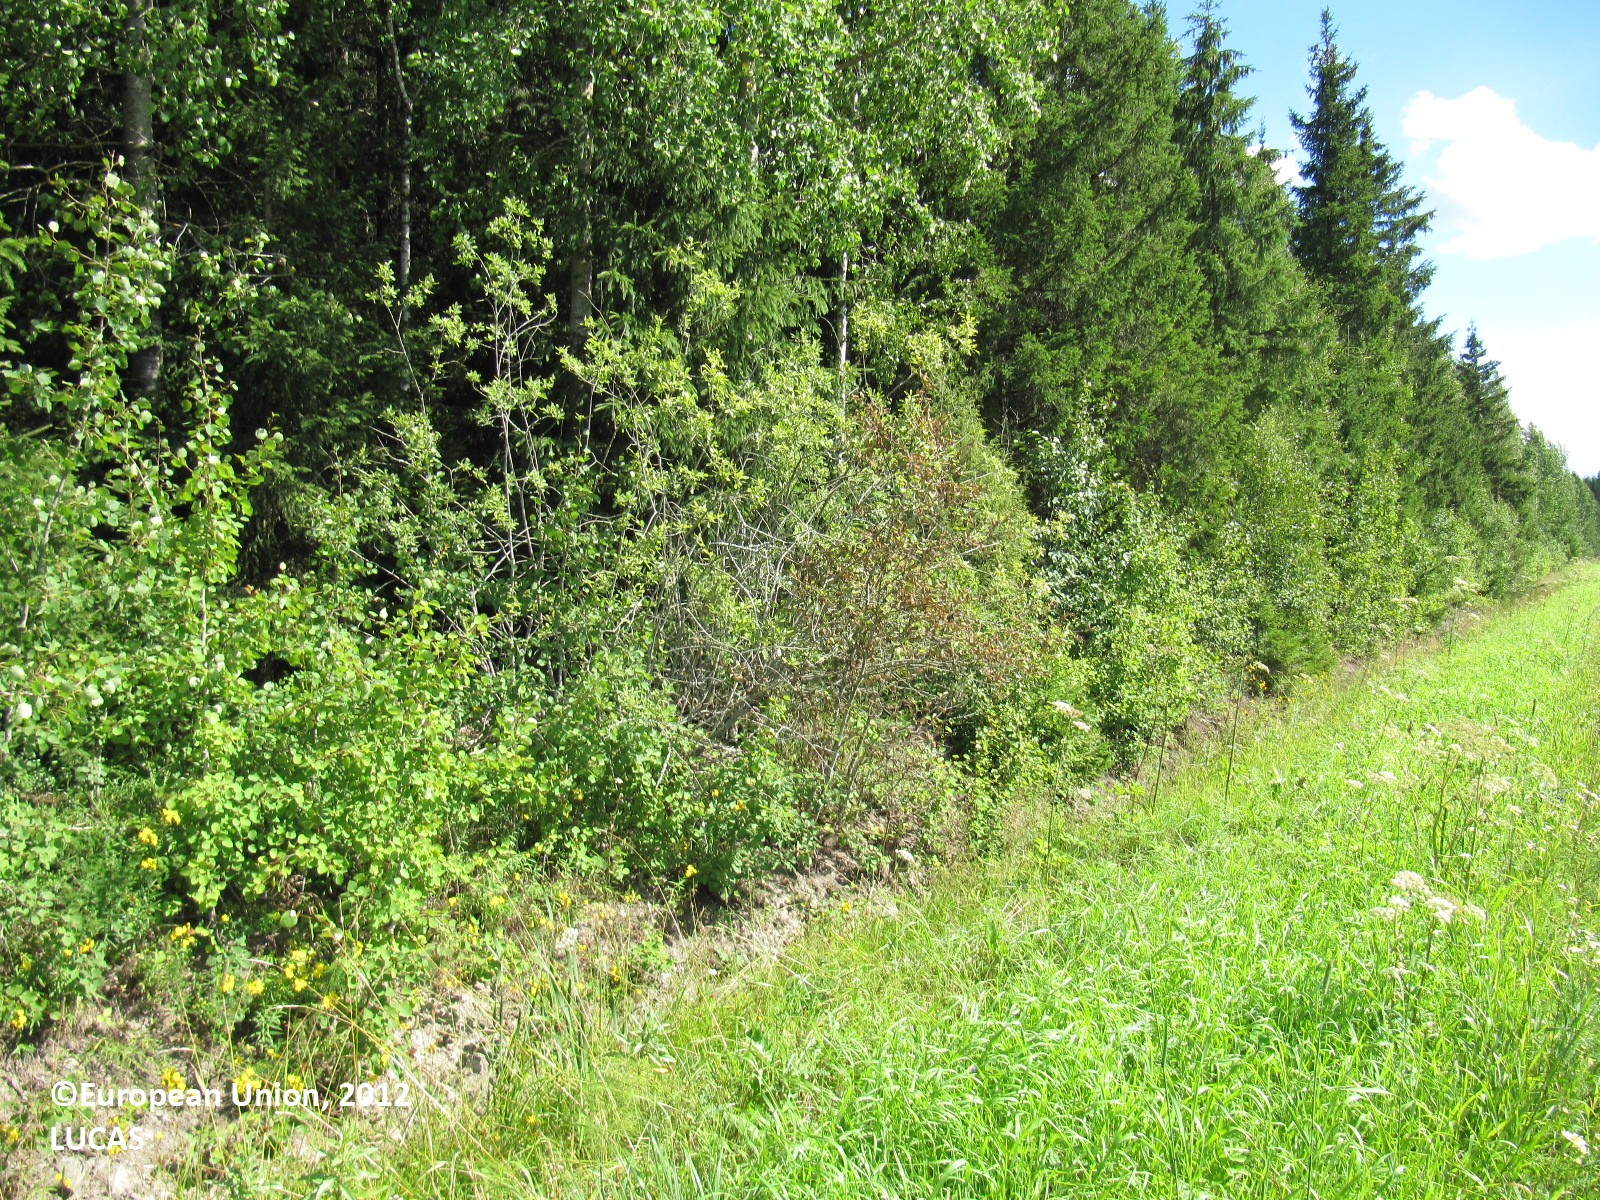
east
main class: Cropland
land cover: Rape and turnip rape
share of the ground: > 75 %
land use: Agriculture (excluding fallow land and kitchen gardens)
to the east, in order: Rape and turnip rape; Spontaneously vegetated surfaces; Ditches and canals; Spruce dominated mixed woodland; Tracks; Spruce dominated coniferous woodland
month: August
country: FI
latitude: 60.6338
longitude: 23.2249
